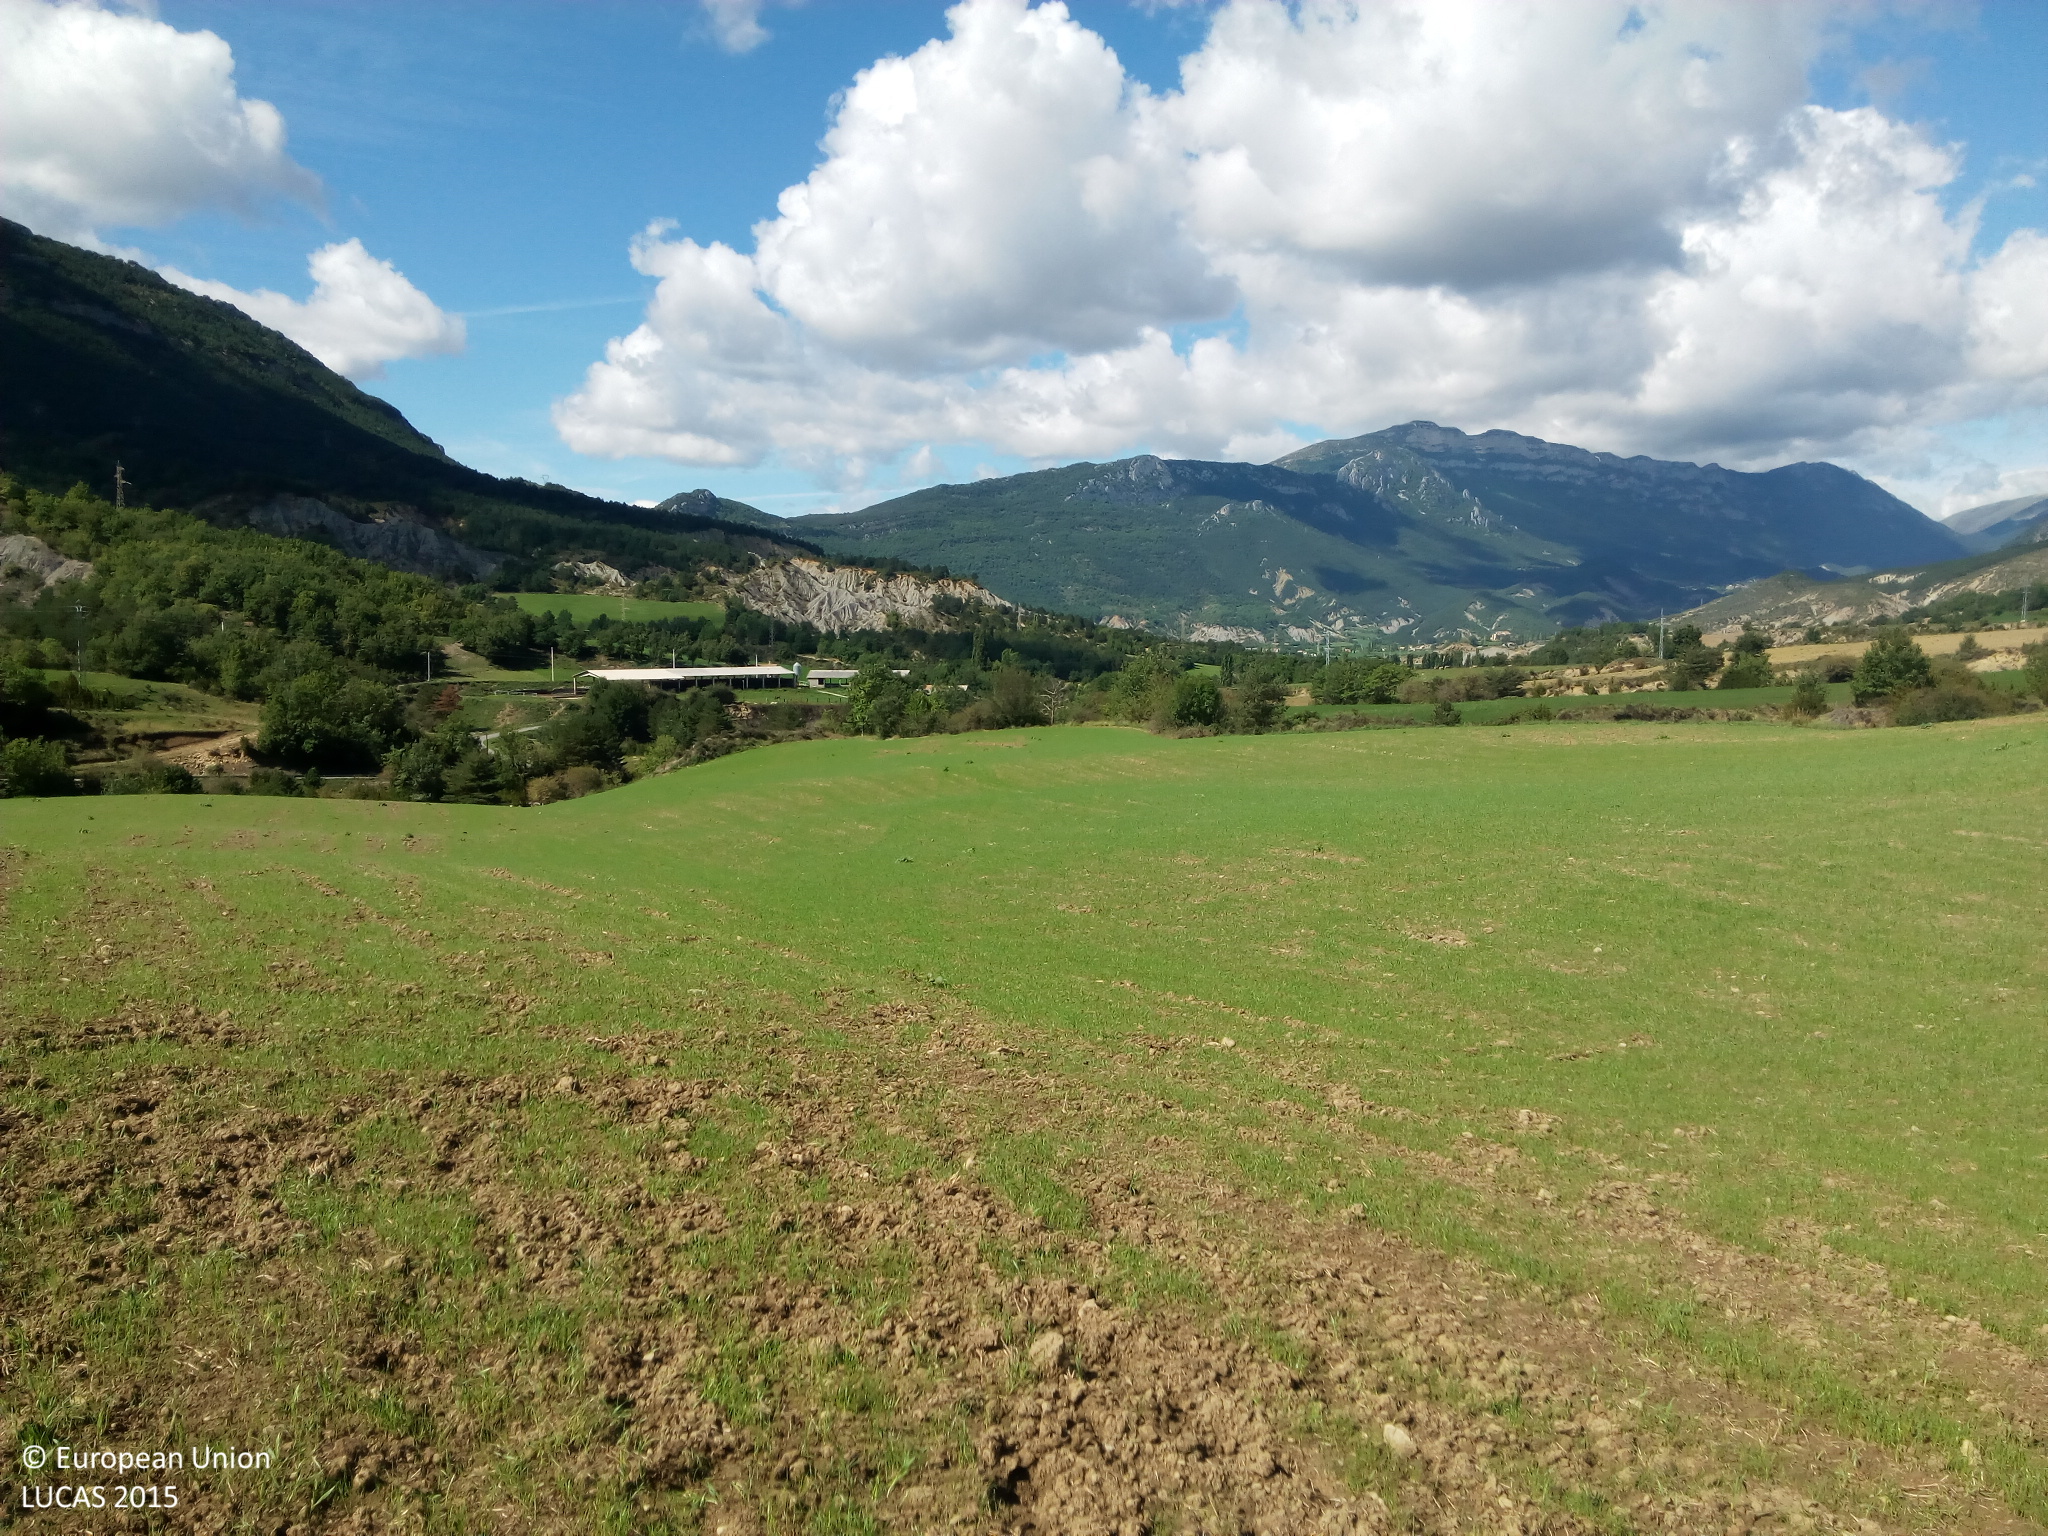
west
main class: Grassland
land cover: Spontaneously vegetated surfaces
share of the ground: > 75 %
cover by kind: herbaceous plants 75 %, unconsolidated bare surface 25 %
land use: Fallow land
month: September
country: ES
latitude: 42.4011
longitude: 0.4435
